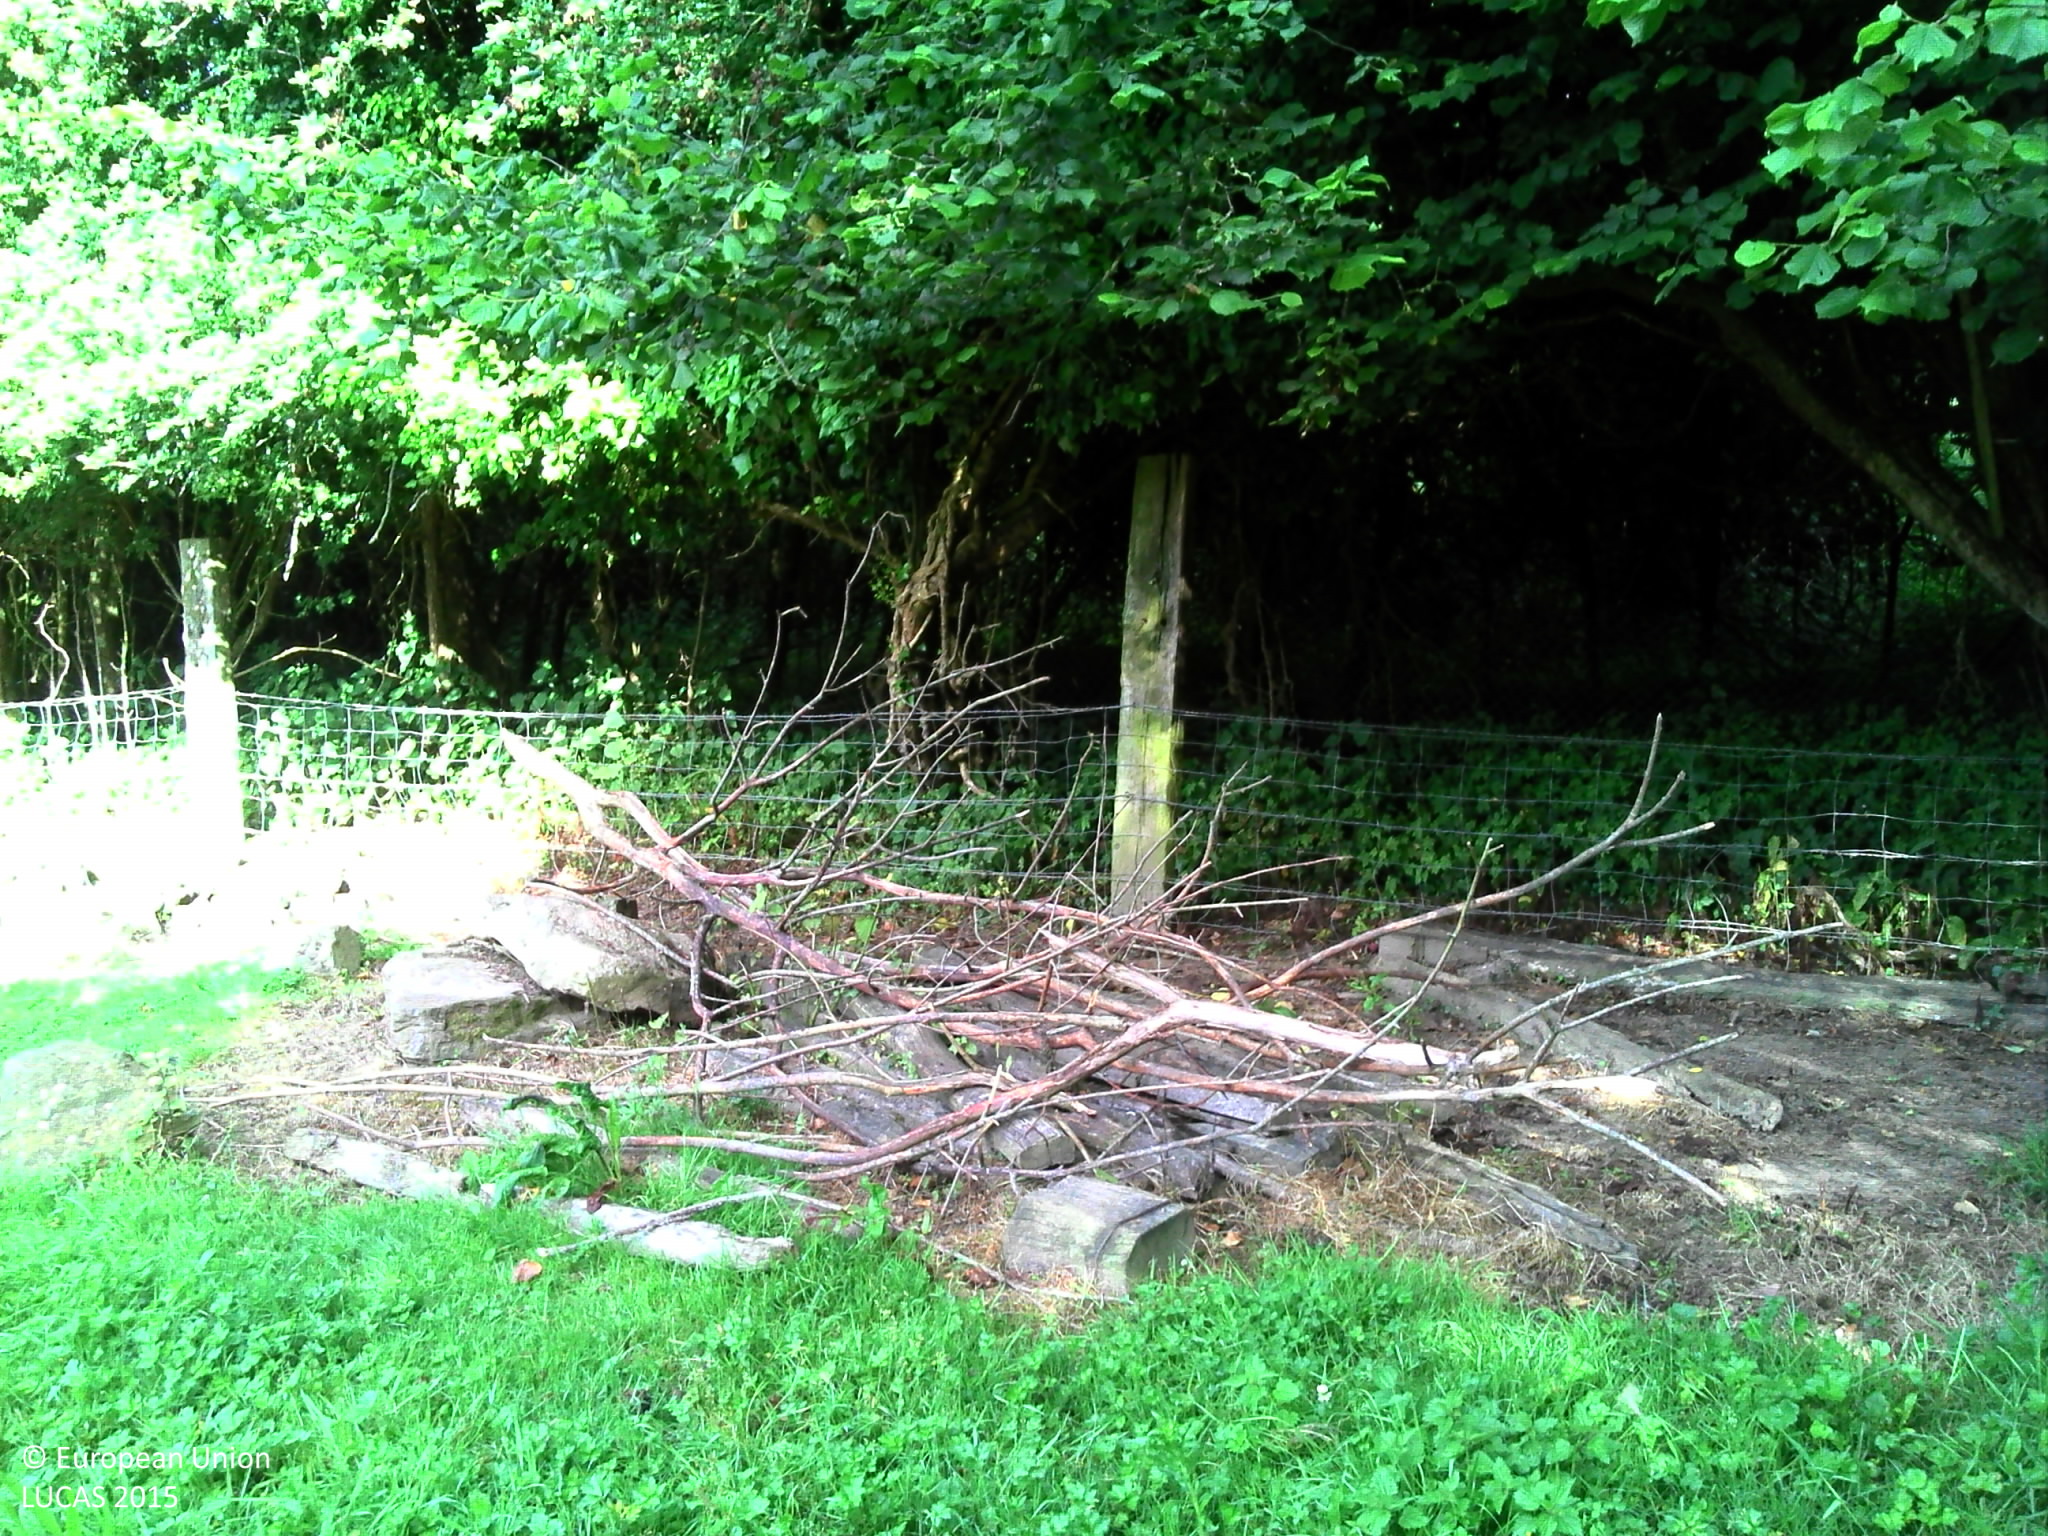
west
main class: Grassland
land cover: Grassland without tree/shrub cover
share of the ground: > 75 %
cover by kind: herbaceous plants 100 %
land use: Agriculture (excluding fallow land and kitchen gardens)
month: June
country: FR
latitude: 49.0782
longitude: -1.4520
